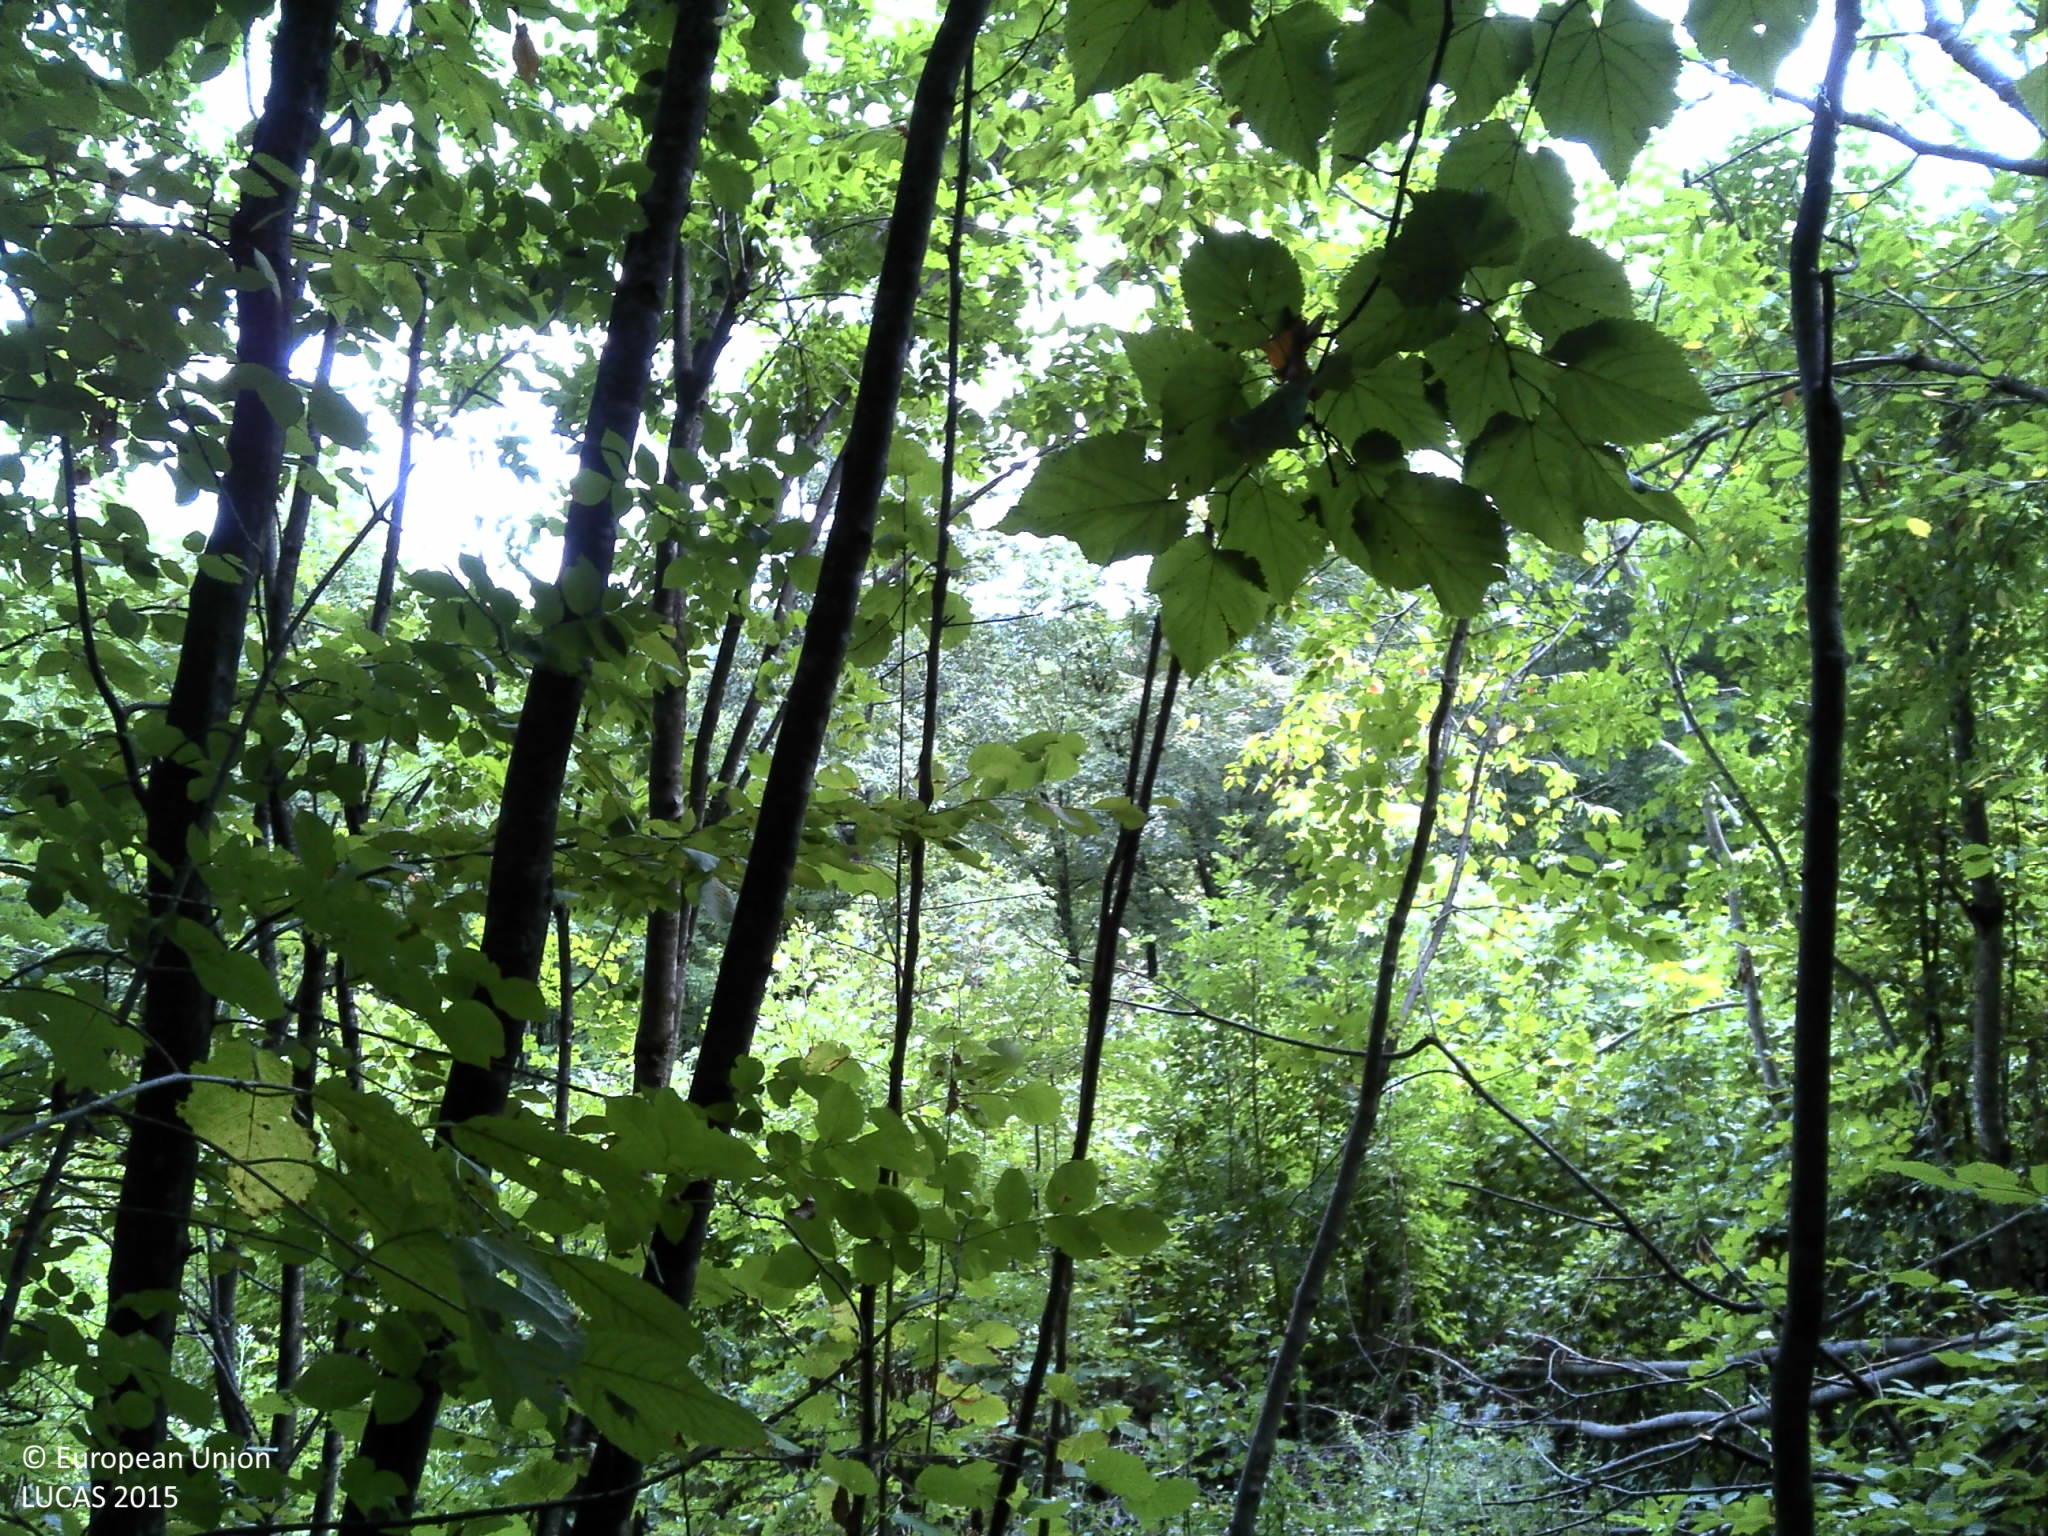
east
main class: Woodland
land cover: Broadleaved woodland
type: acidophilous oak and oak-birch forest
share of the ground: > 75 %
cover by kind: broadleaved forest trees 100 %
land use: Forestry
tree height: > 5 m
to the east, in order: Broadleaved woodland; Shrubland without tree cover; Electric lines; Shrubland without tree cover; Broadleaved woodland; Shrubland without tree cover; Electric lines; Shrubland without tree cover; Broadleaved woodland; Tracks; Broadleaved woodland
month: September
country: HR
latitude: 45.3010
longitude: 15.2623
